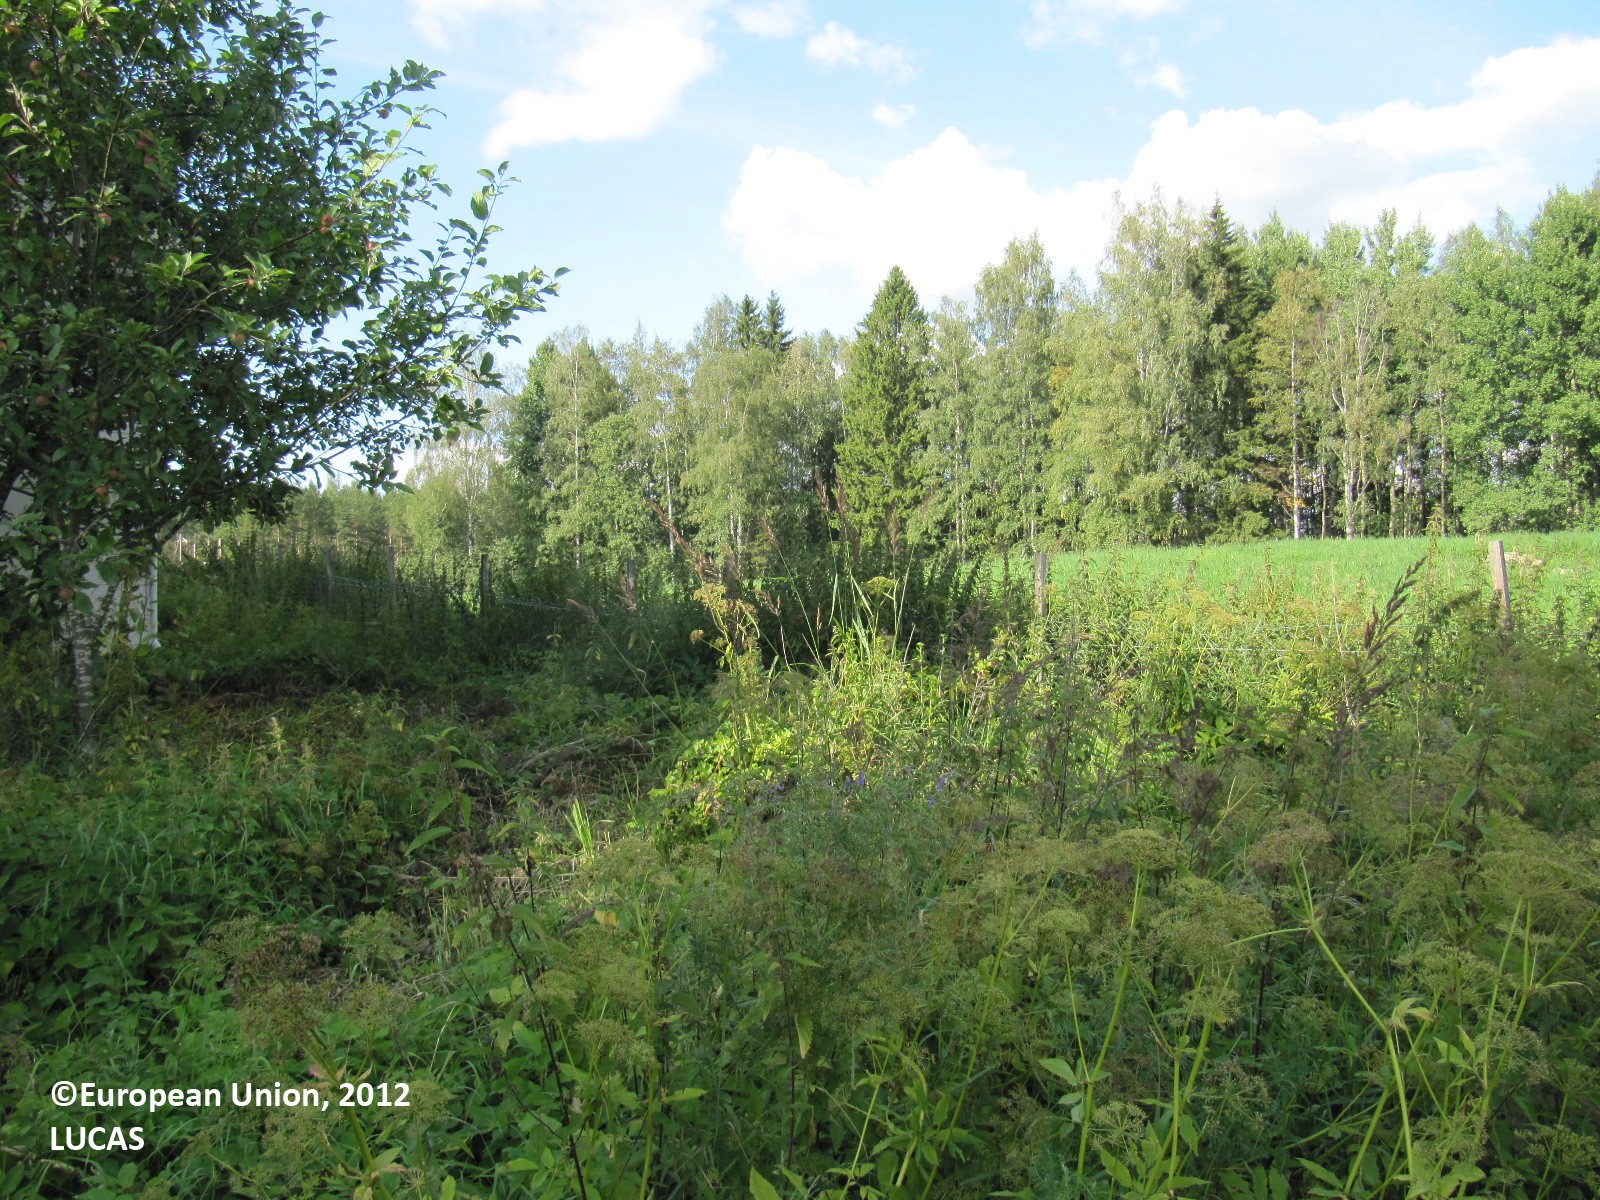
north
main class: Cropland
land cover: Other fruit trees and berries
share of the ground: 50 - 75 %
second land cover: Apple fruit
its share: 25 - 50 %
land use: Kitchen garden
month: August
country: FI
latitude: 60.5887
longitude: 24.4348
